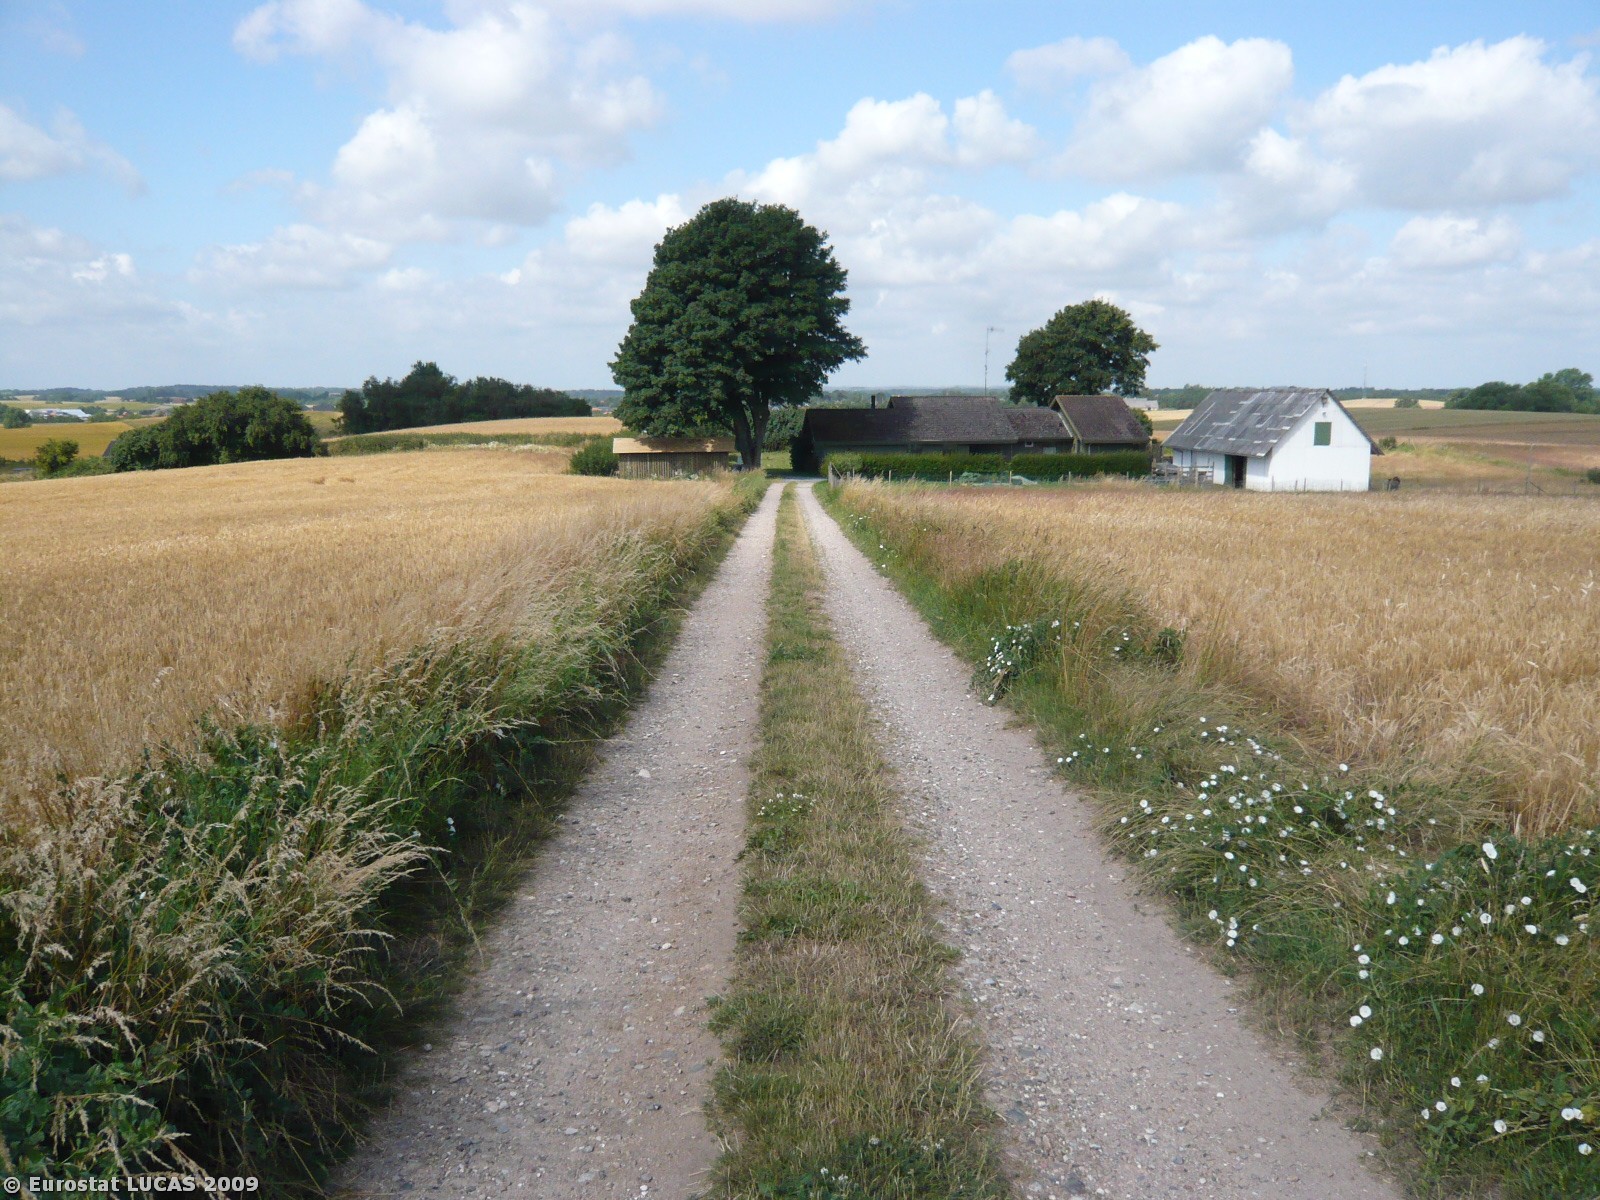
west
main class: Cropland
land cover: Common wheat
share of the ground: > 75 %
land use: Agriculture (excluding fallow land and kitchen gardens)
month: July
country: DK
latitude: 55.6739
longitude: 11.6363
